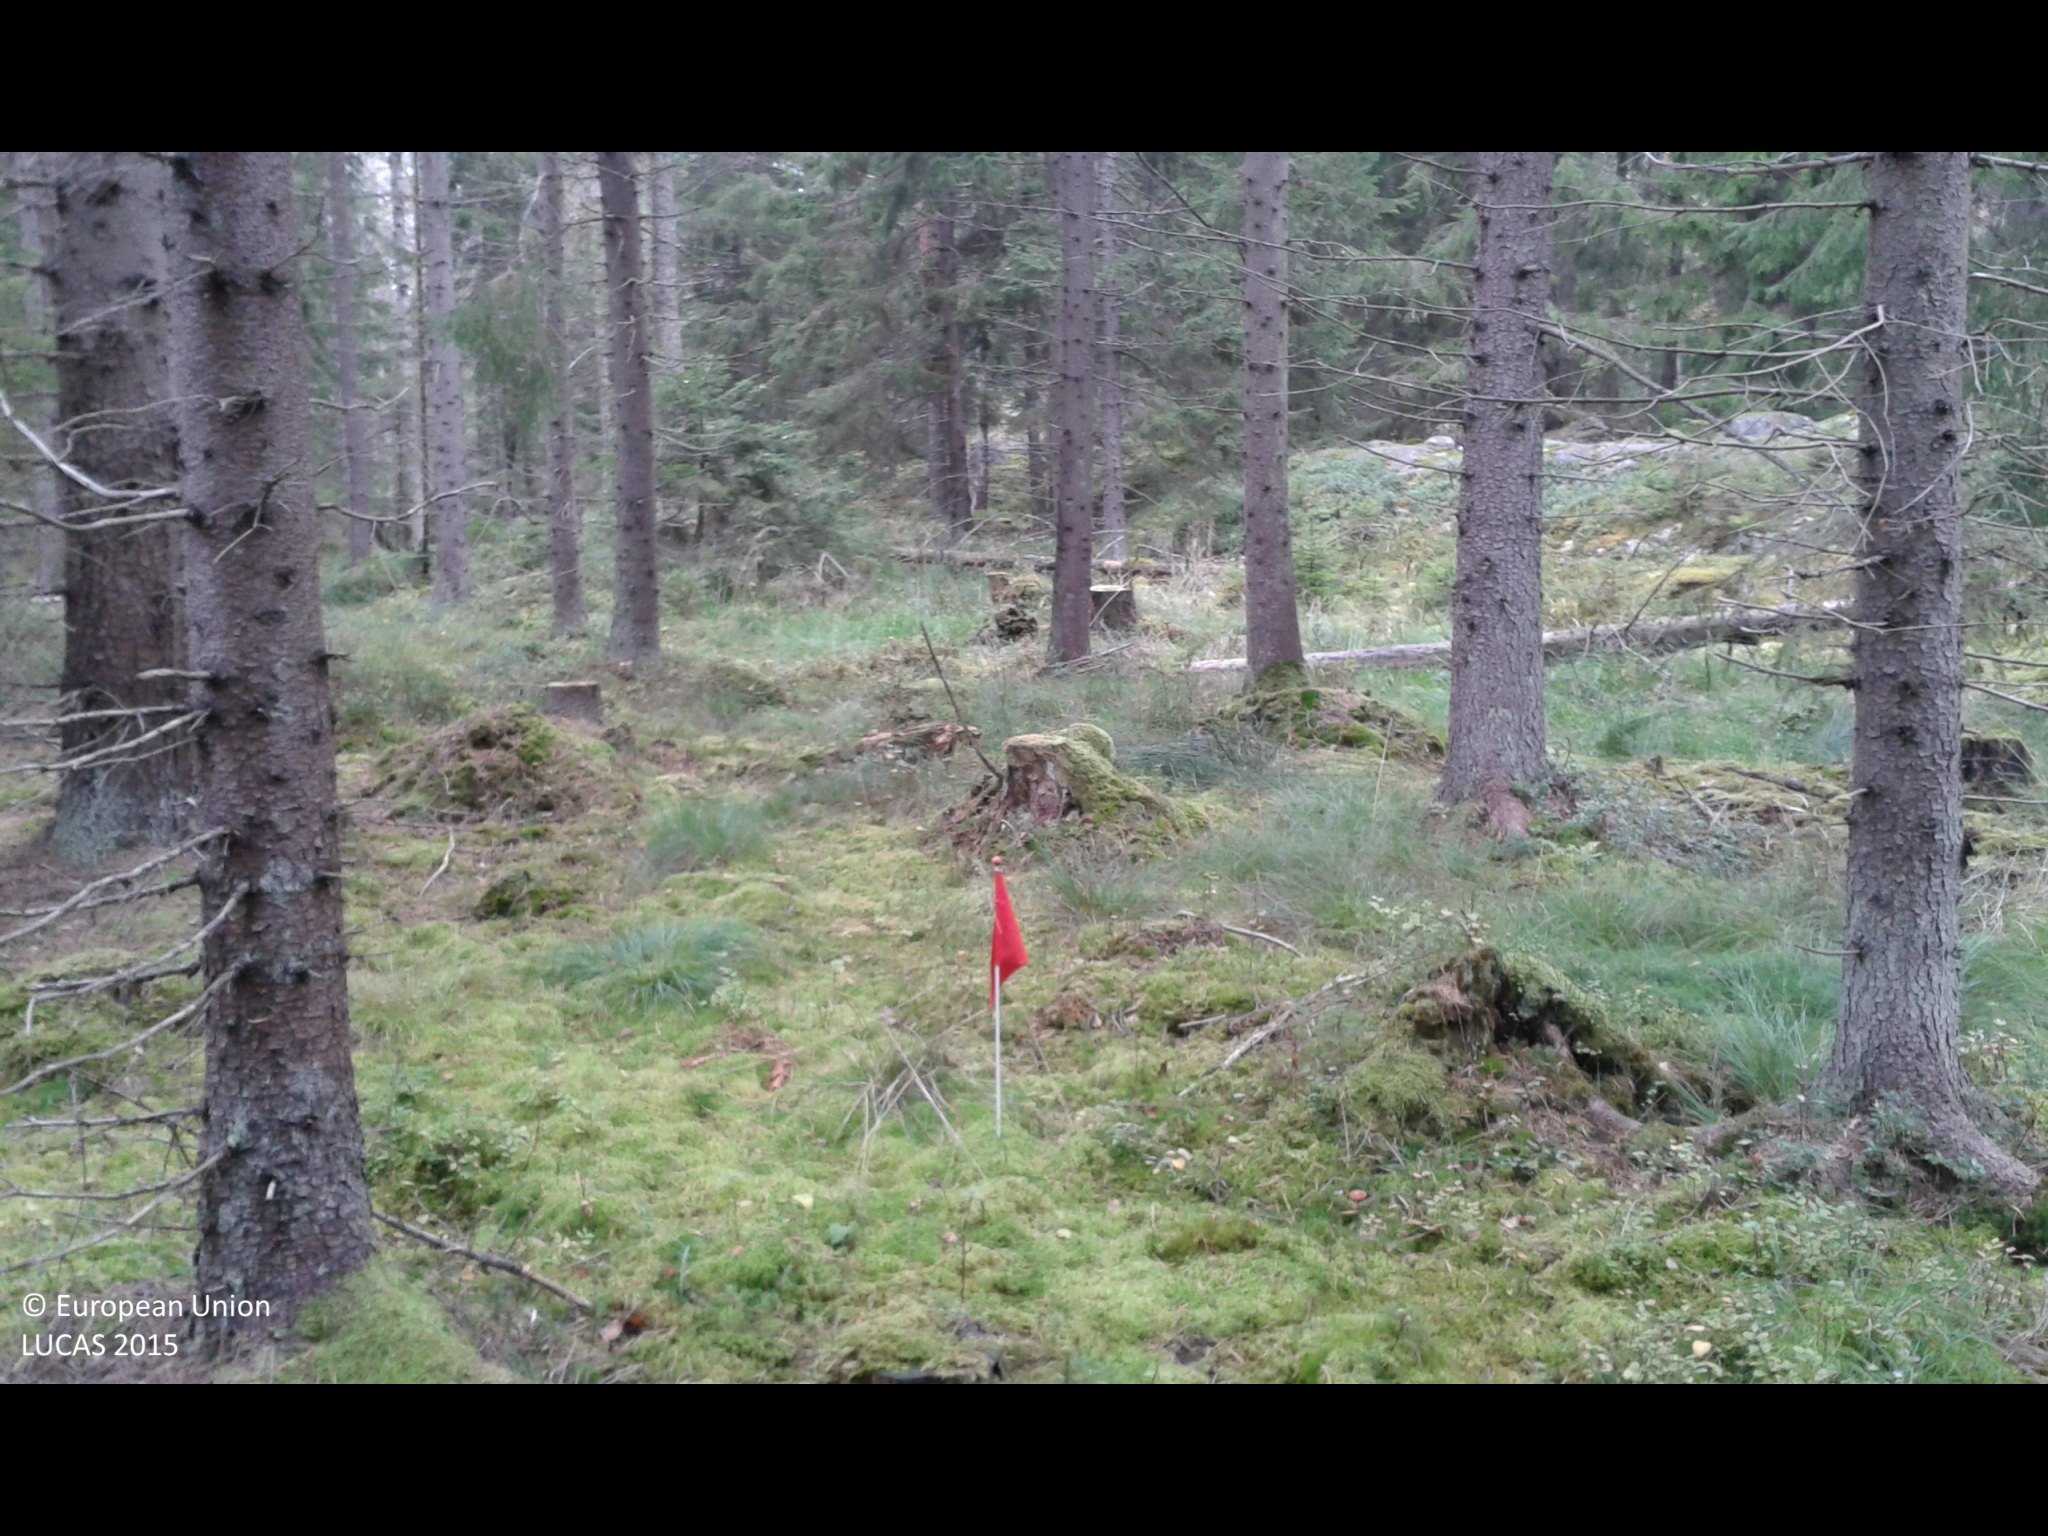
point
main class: Woodland
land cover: Spruce dominated coniferous woodland
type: boreal forest
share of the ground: 50 - 75 %
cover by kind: coniferous forest trees 70 %, herbaceous plants 30 %
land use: Forestry
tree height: > 5 m
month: October
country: SE
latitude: 58.7830
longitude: 17.2456
